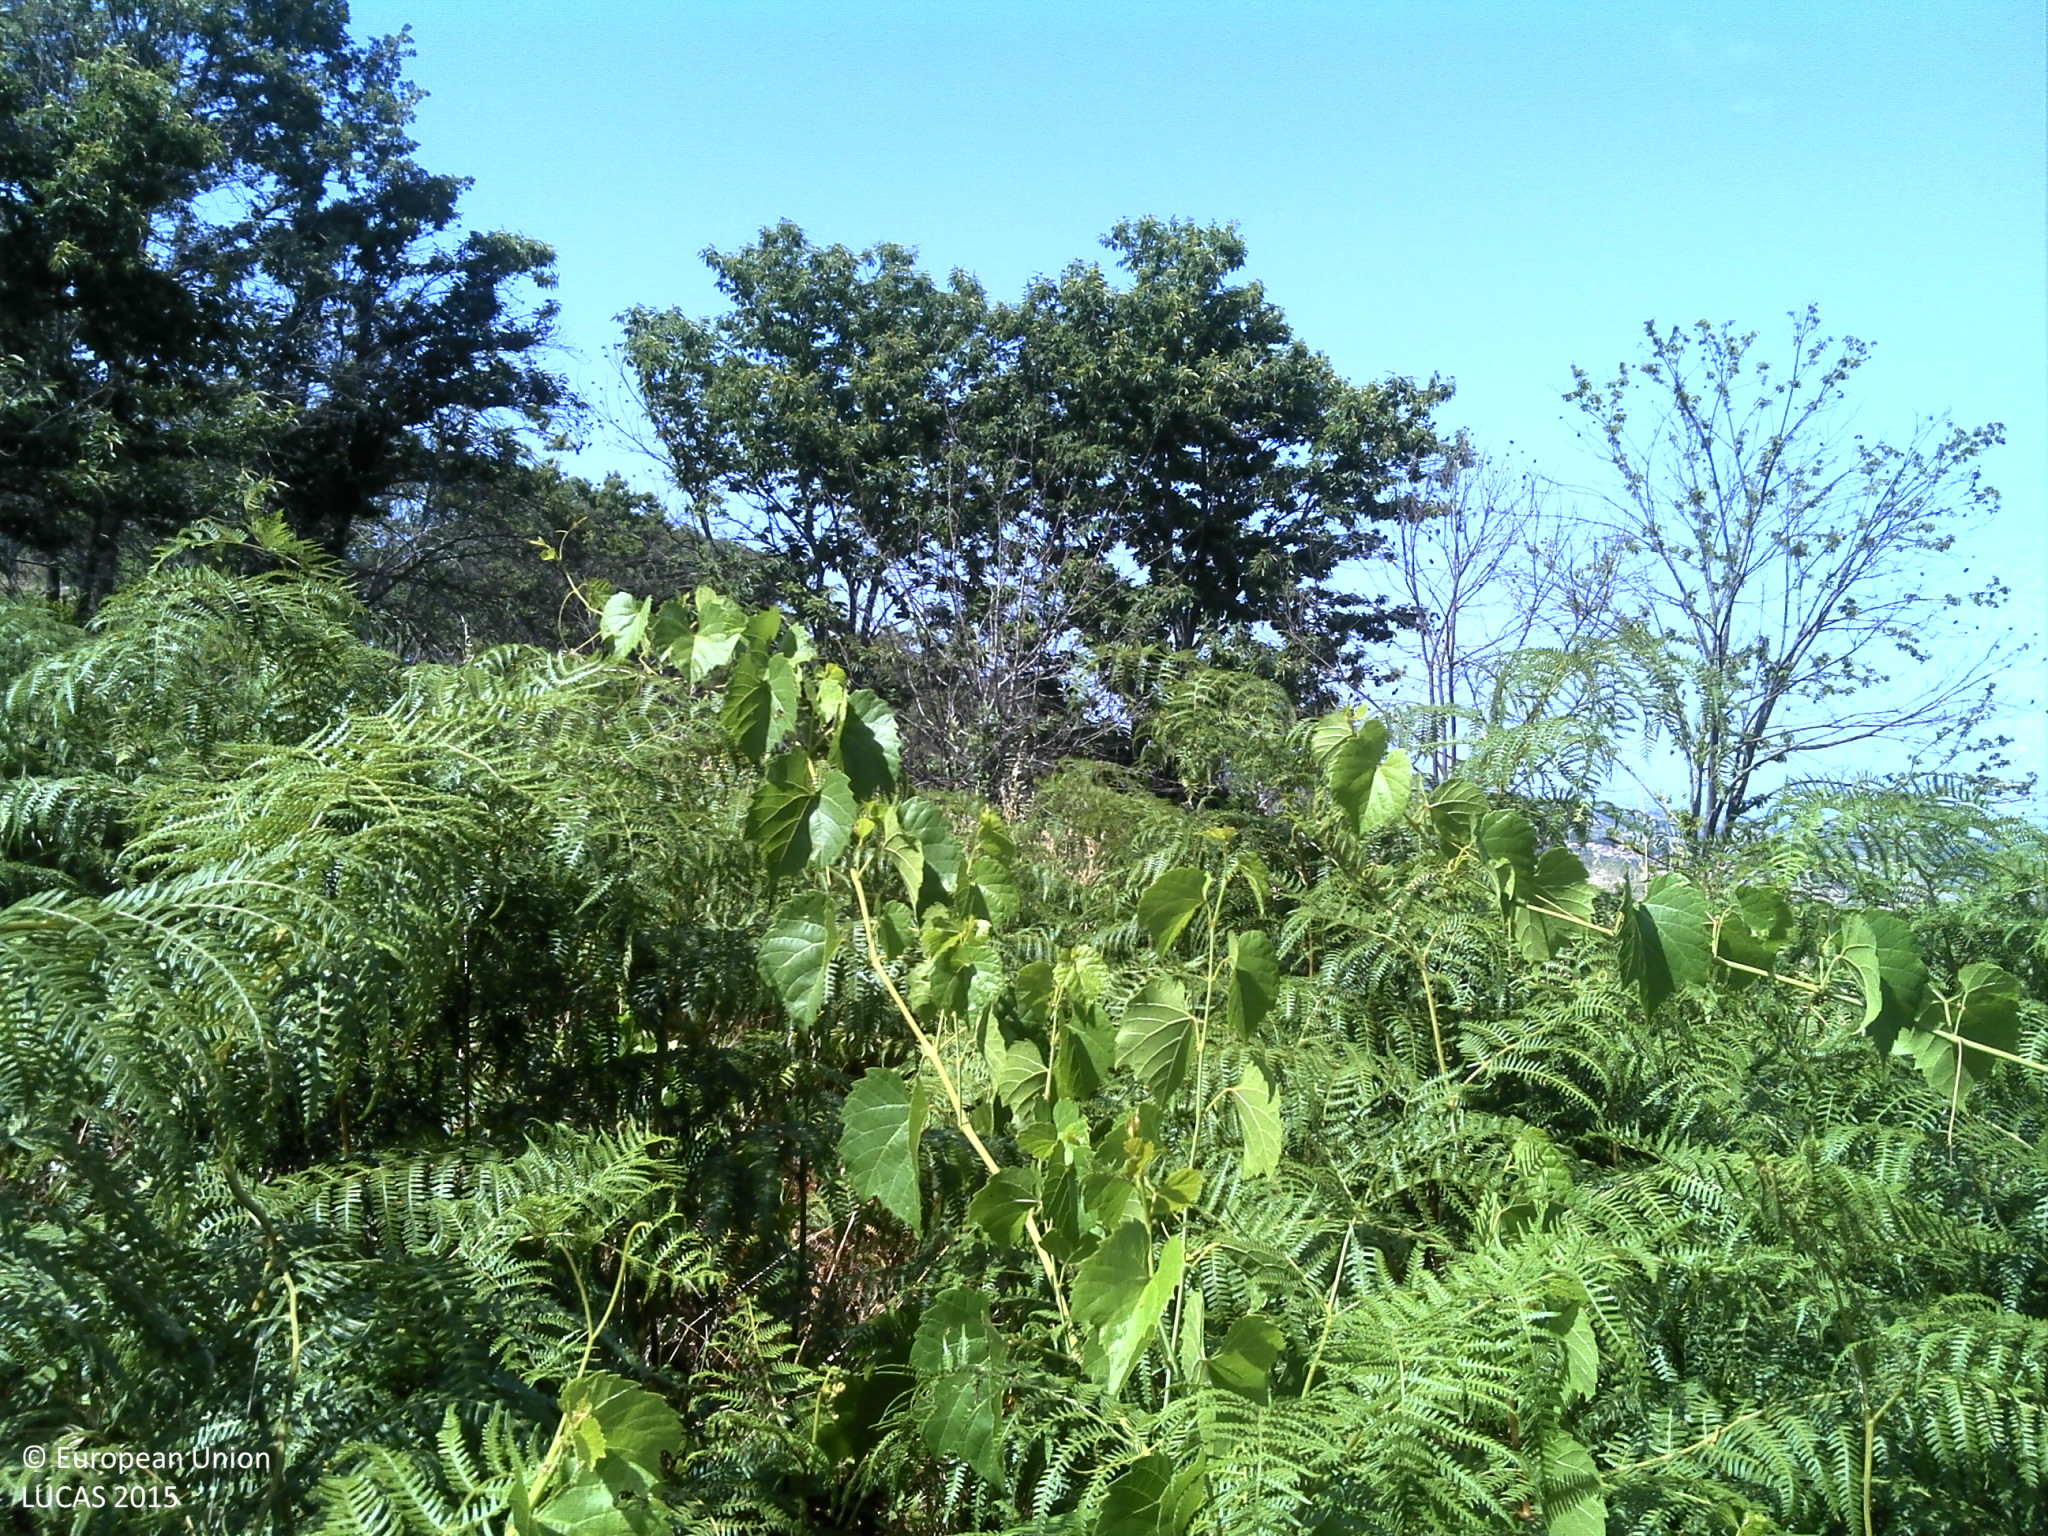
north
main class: Cropland
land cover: Vineyards
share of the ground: 10 - 25 %
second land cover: Spontaneously vegetated surfaces
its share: 25 - 50 %
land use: Abandoned areas
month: July
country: PT
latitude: 40.7959
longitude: -7.3327
